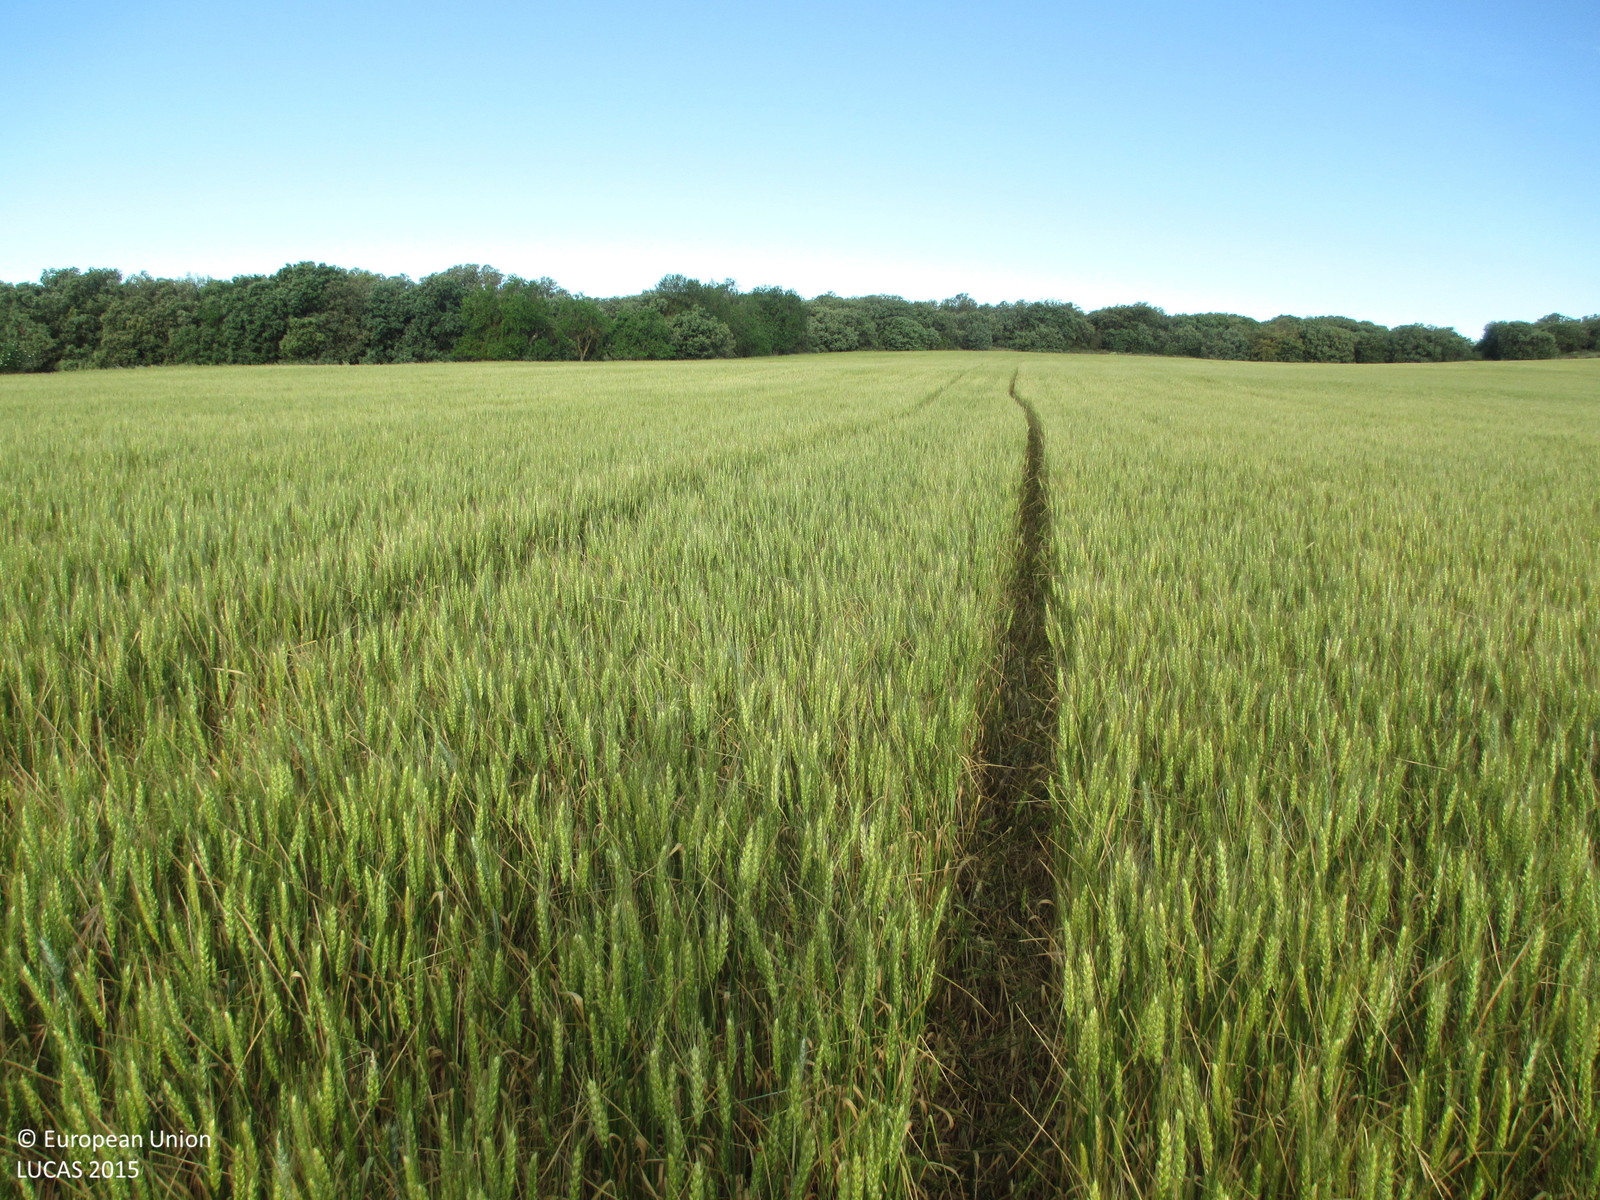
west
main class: Cropland
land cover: Common wheat
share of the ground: > 75 %
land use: Agriculture (excluding fallow land and kitchen gardens)
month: May
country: ES
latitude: 42.1080
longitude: -0.3130
